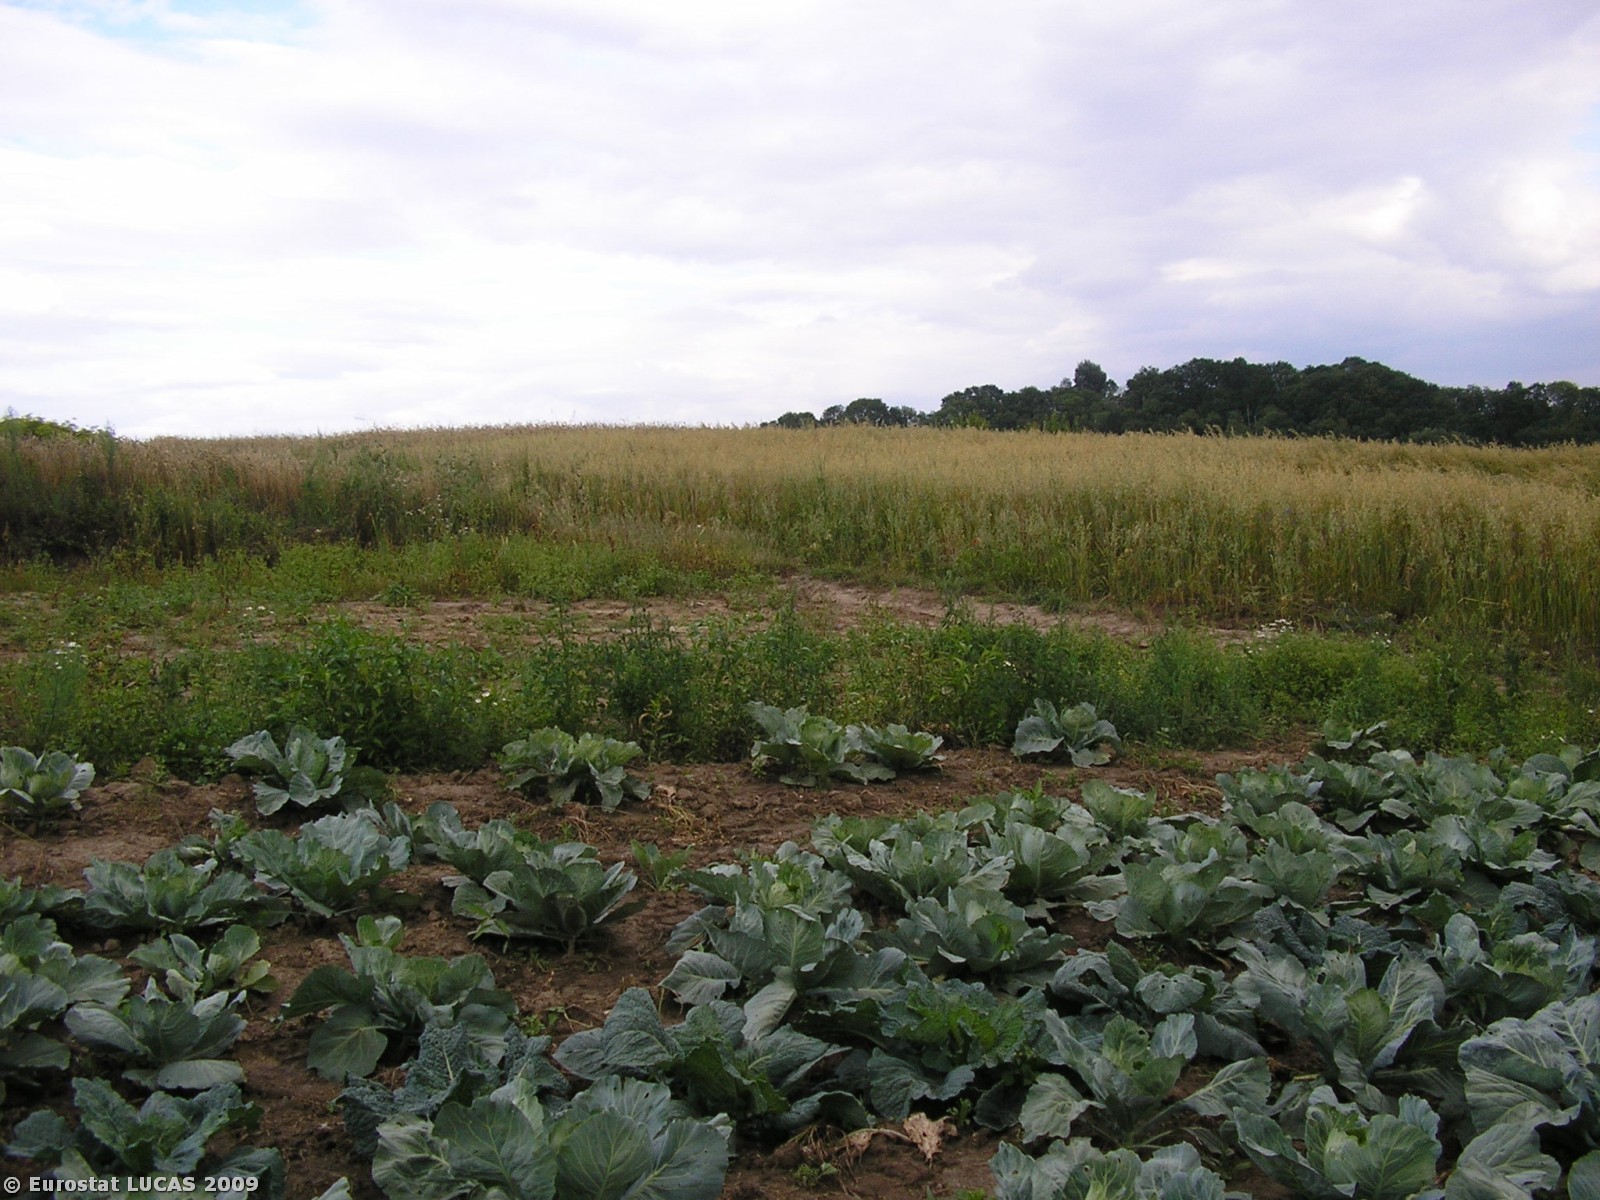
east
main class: Cropland
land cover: Other root crops
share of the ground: 50 - 75 %
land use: Agriculture (excluding fallow land and kitchen gardens)
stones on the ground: < 10 %
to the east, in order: Other root crops; Other fresh vegetables; Grass margins; Tracks; Oats; Common wheat
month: July
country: PL
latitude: 50.1414
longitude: 20.0089
